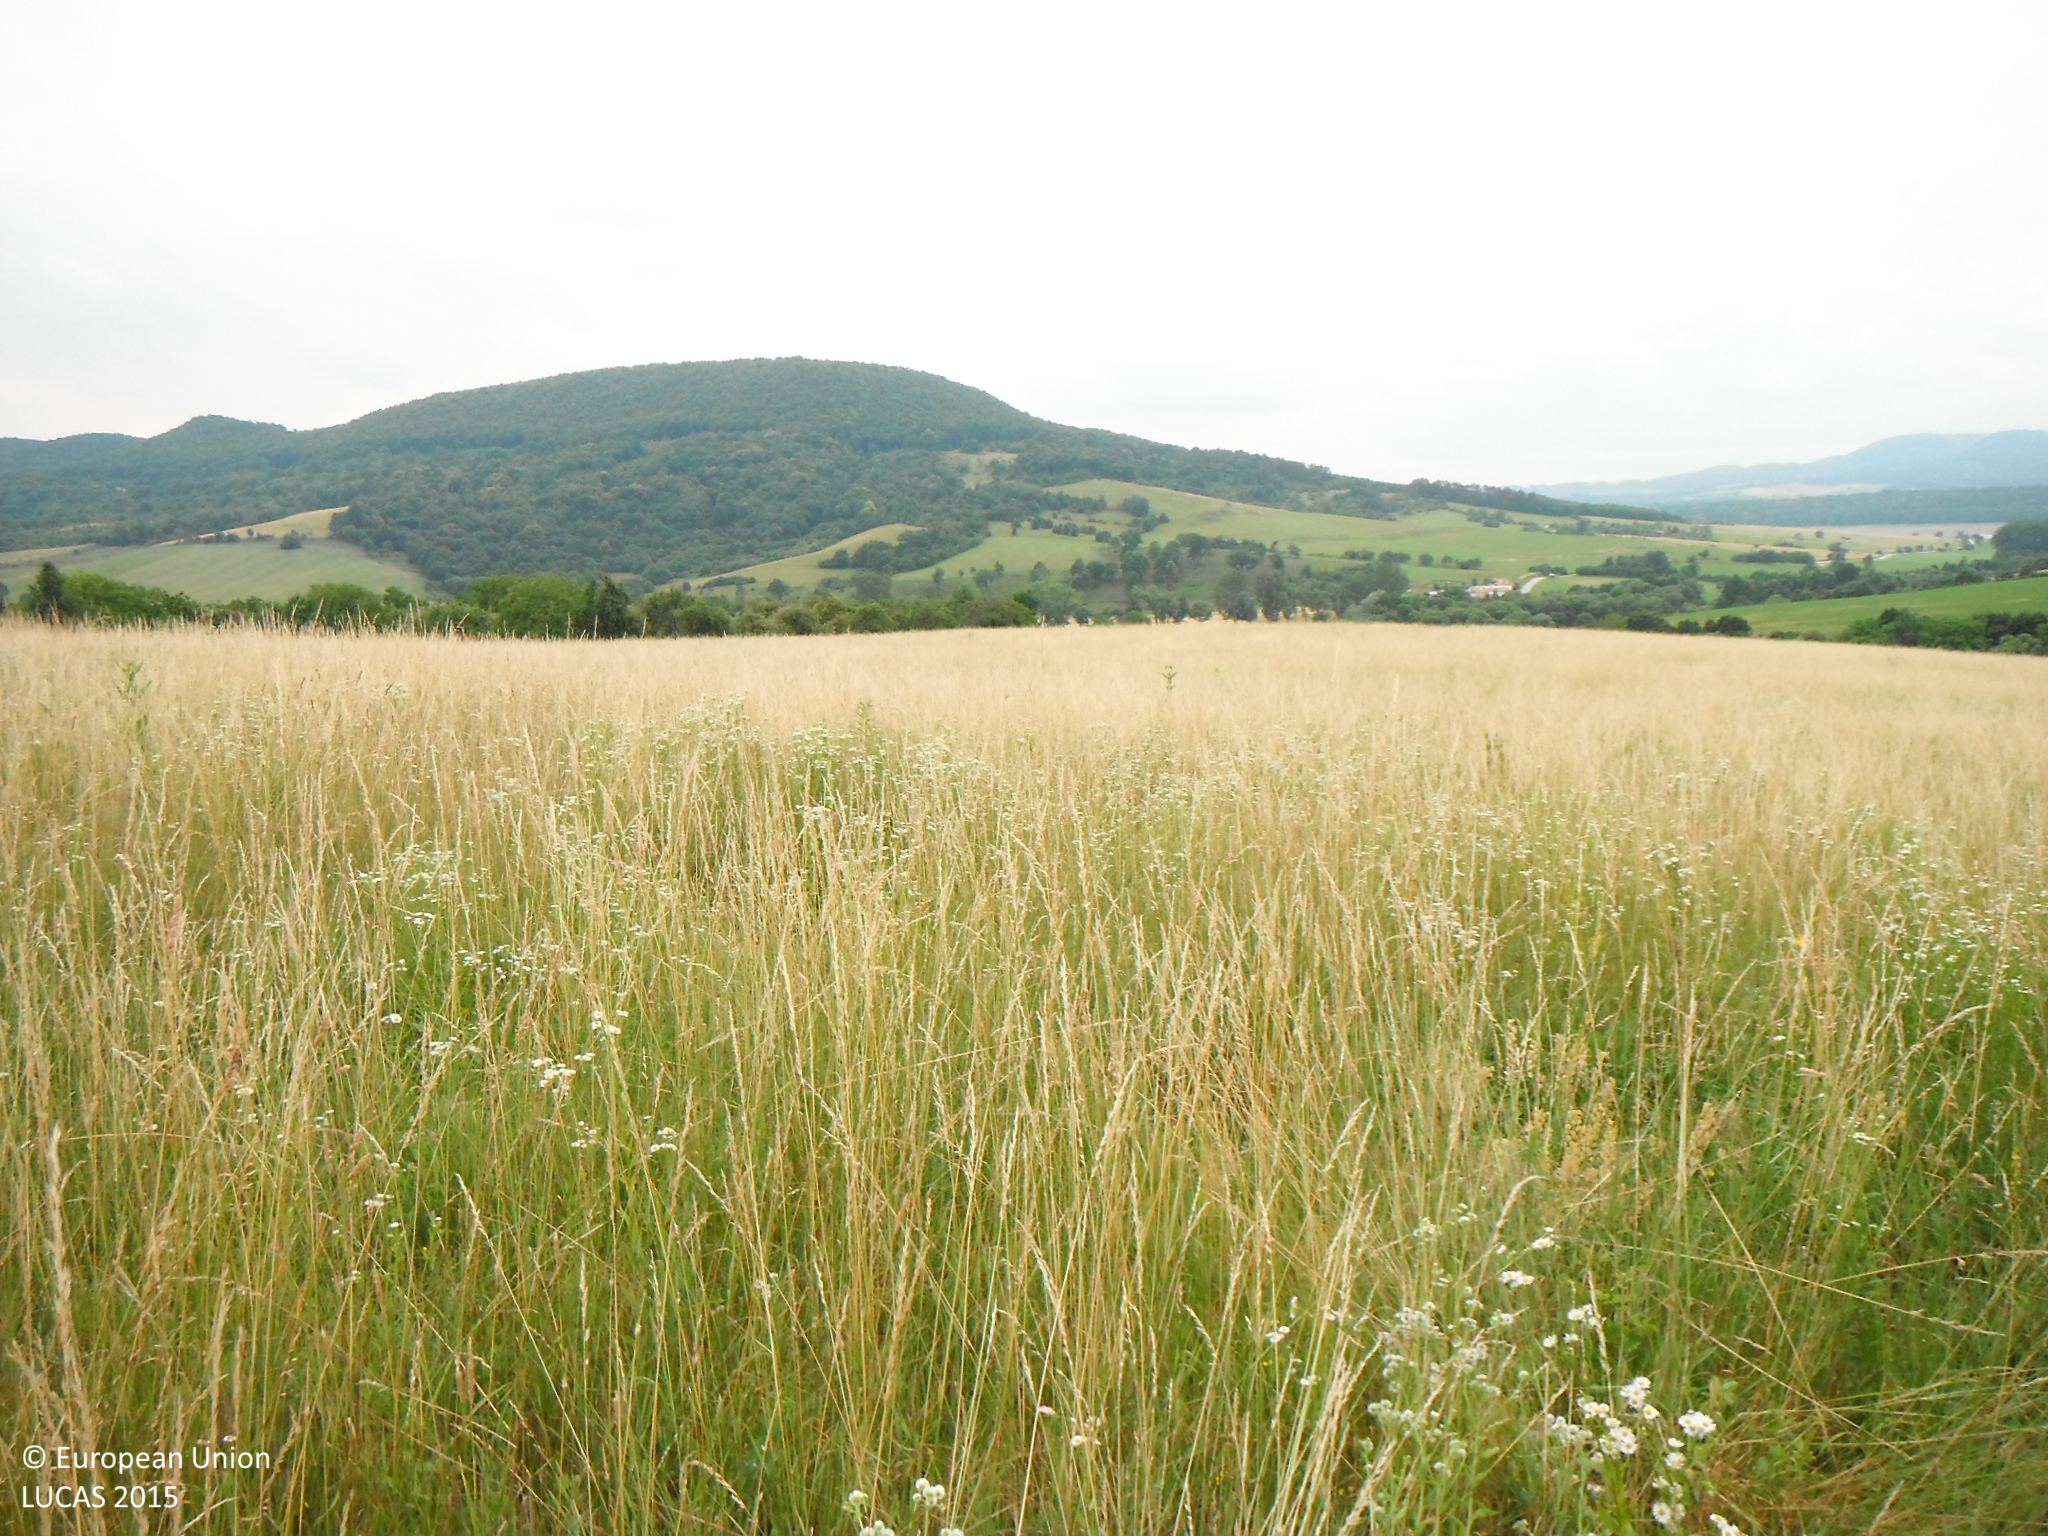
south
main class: Grassland
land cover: Grassland without tree/shrub cover
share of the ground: > 75 %
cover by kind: herbaceous plants 100 %
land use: Agriculture (excluding fallow land and kitchen gardens)
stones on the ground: < 10 %
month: June
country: SK
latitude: 48.5007
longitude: 20.1135
